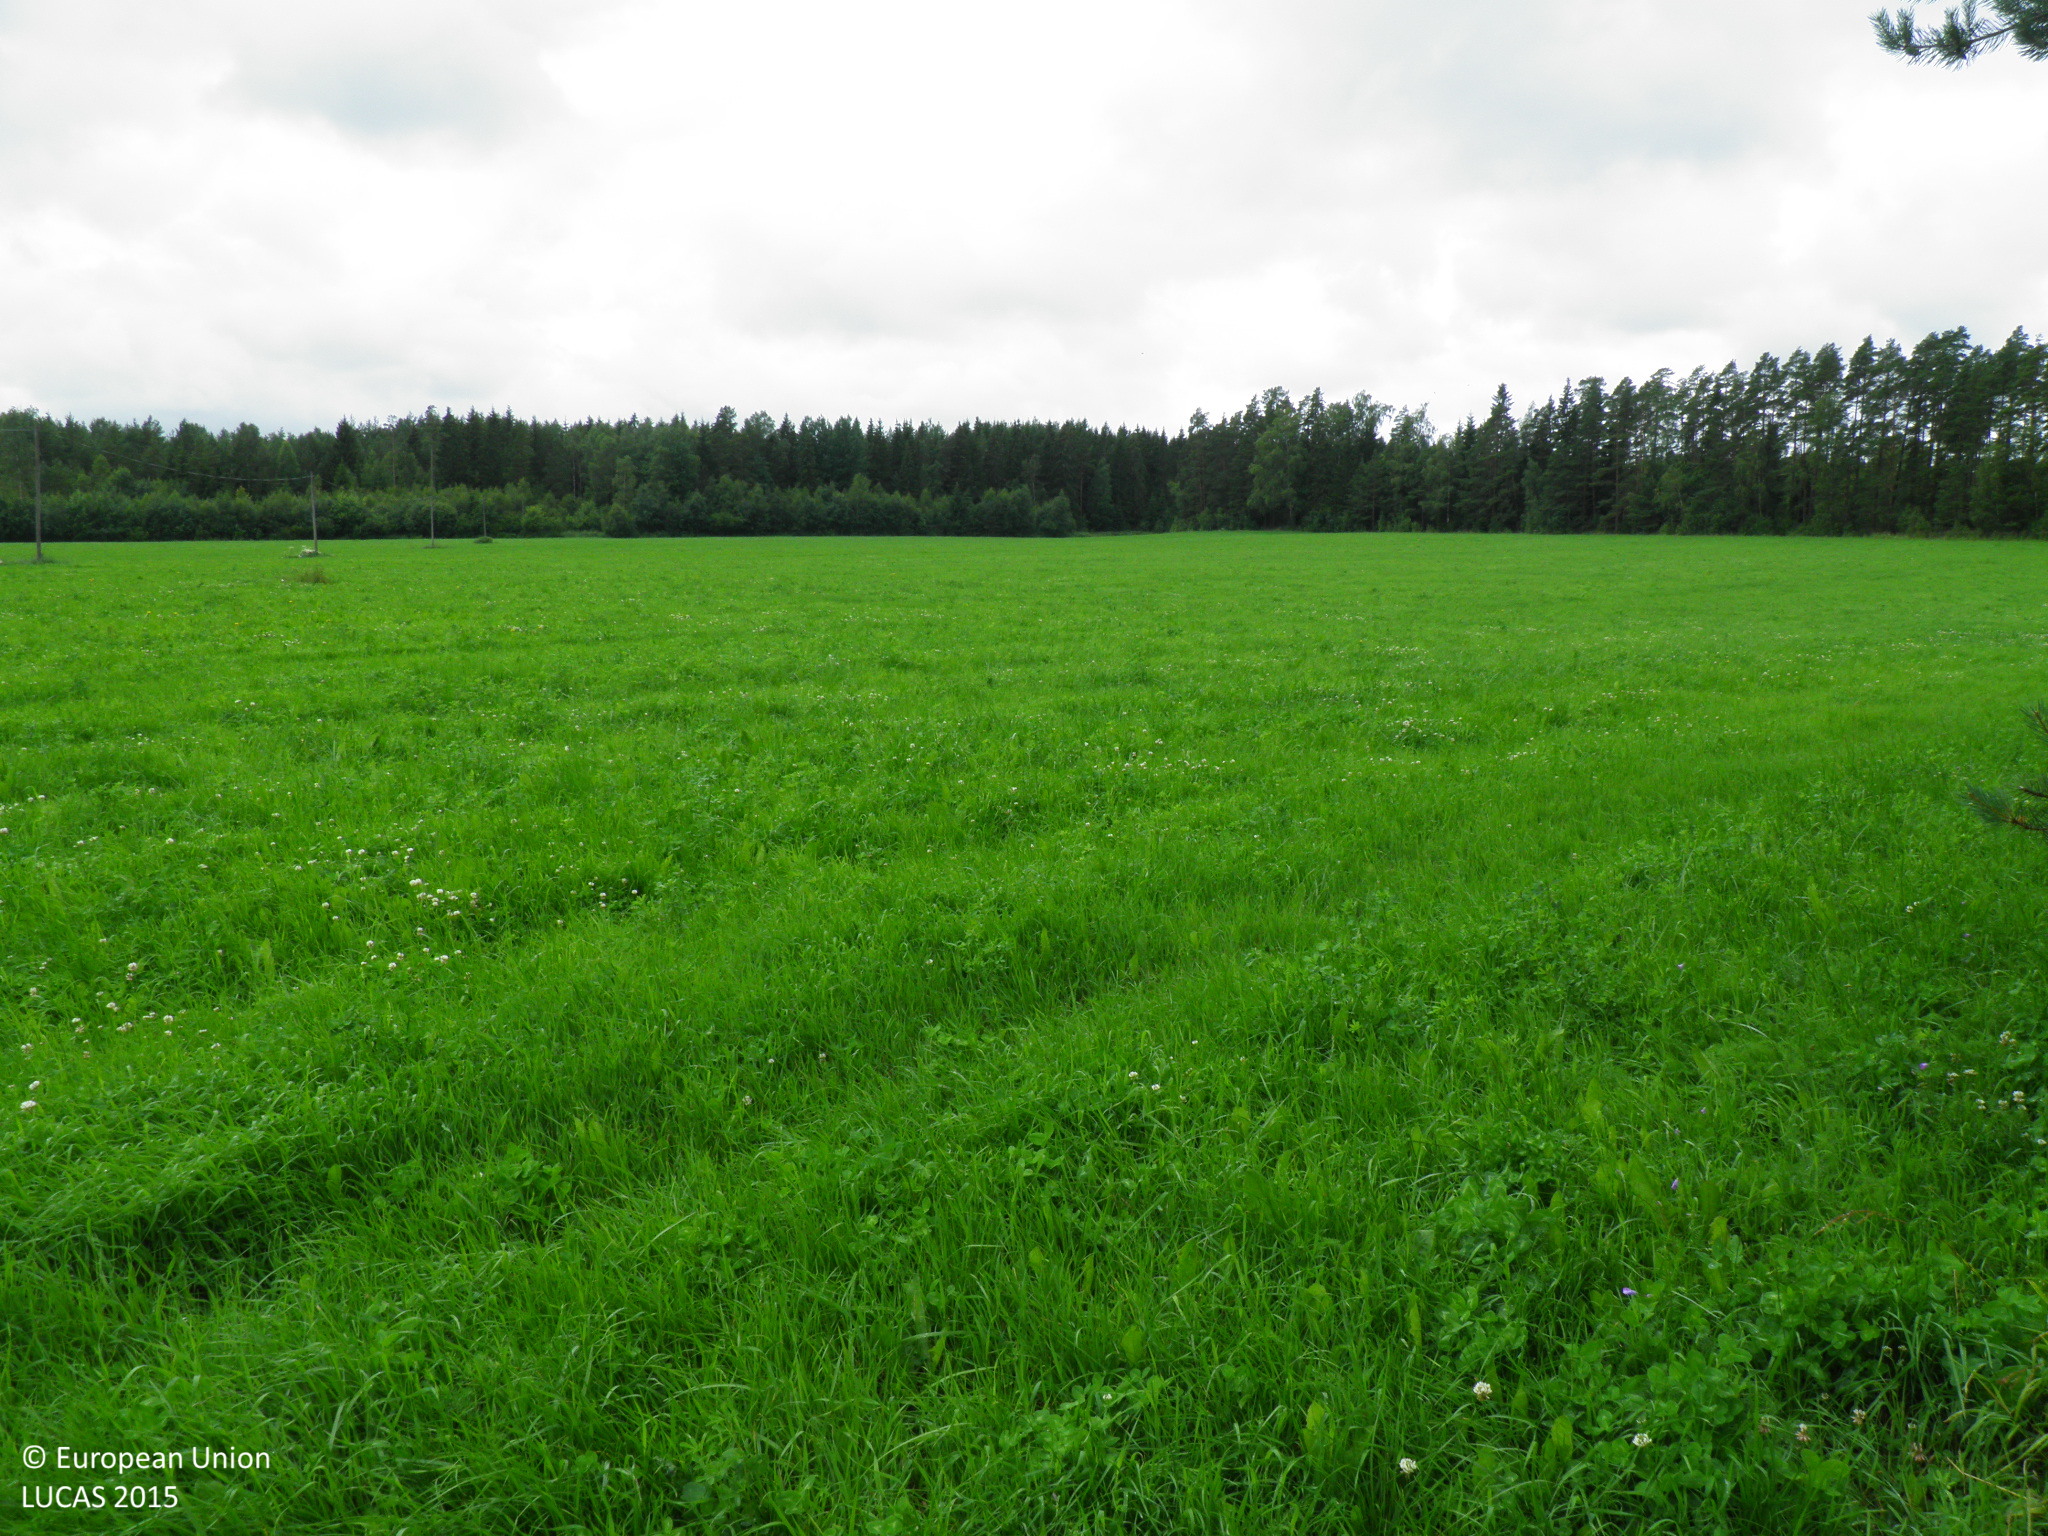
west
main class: Cropland
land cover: Temporary grasslands
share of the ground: > 75 %
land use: Agriculture (excluding fallow land and kitchen gardens)
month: July
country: FI
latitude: 60.6512
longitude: 21.5614
